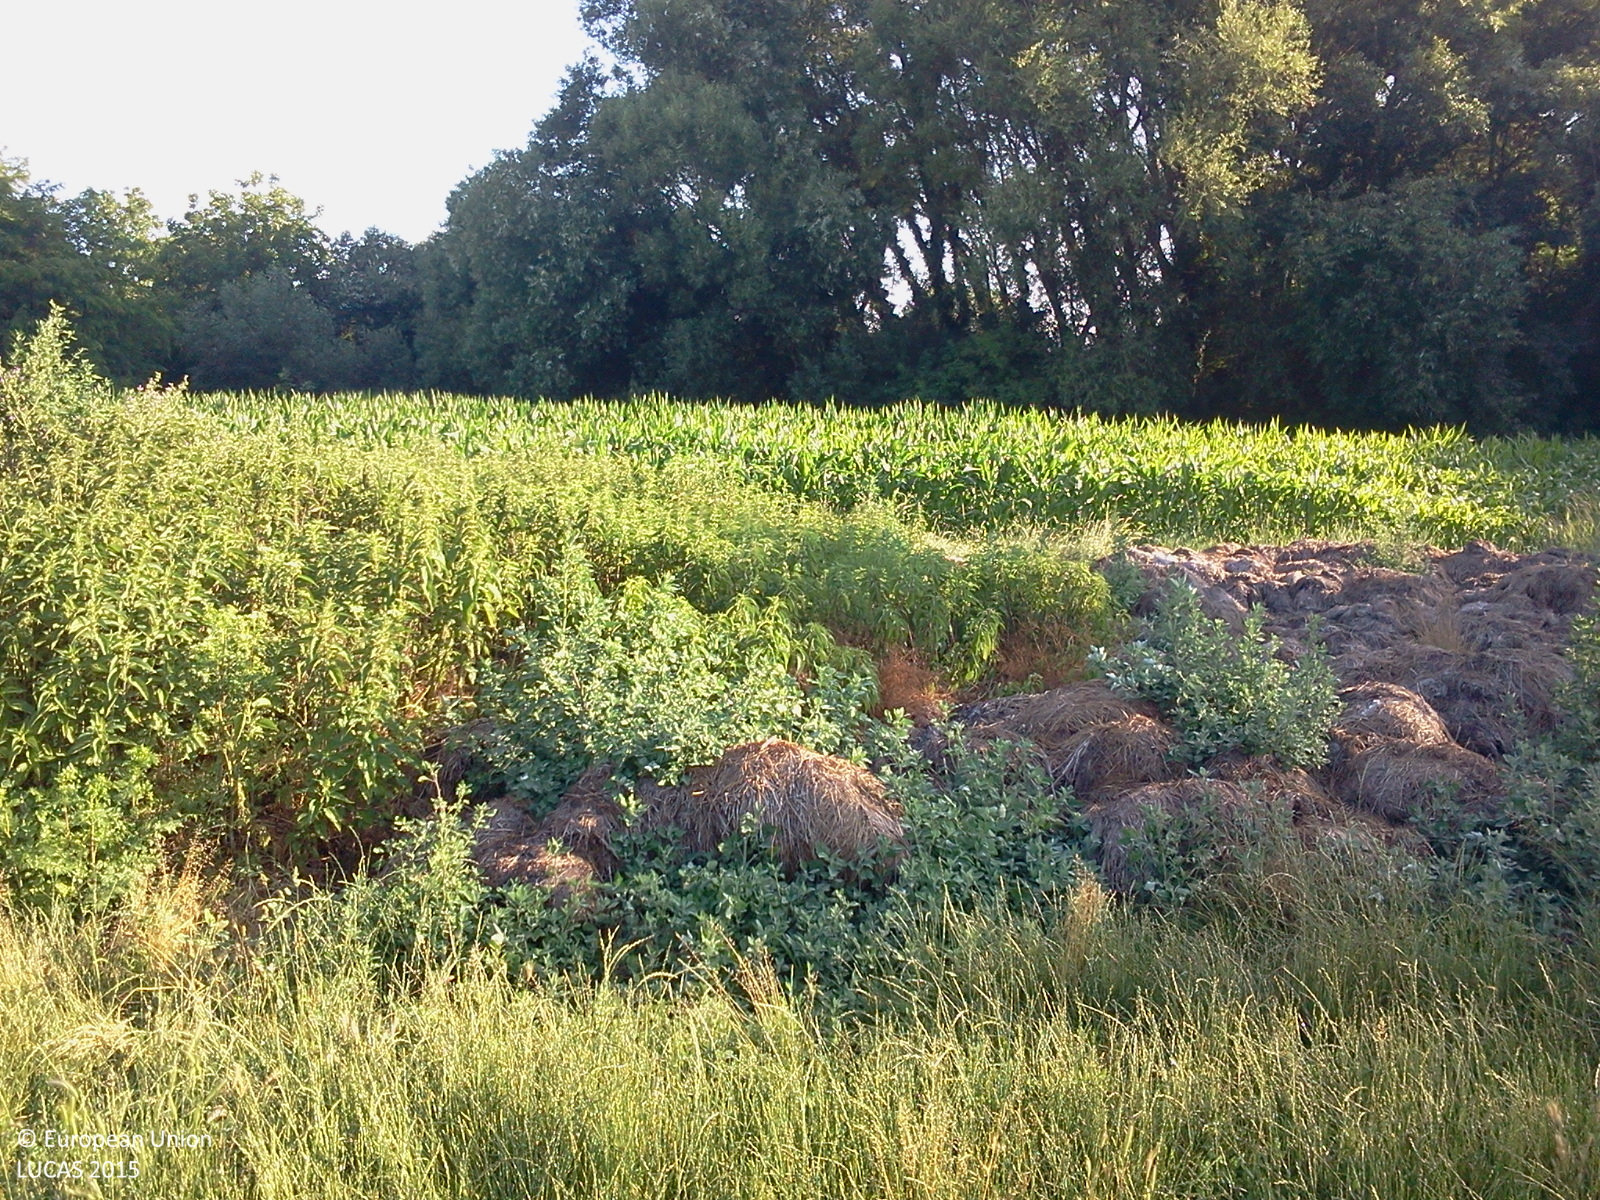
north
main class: Grassland
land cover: Spontaneously vegetated surfaces
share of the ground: > 75 %
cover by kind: herbaceous plants 100 %
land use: Agriculture (excluding fallow land and kitchen gardens)
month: June
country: HU
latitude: 46.7291
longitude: 17.1093
